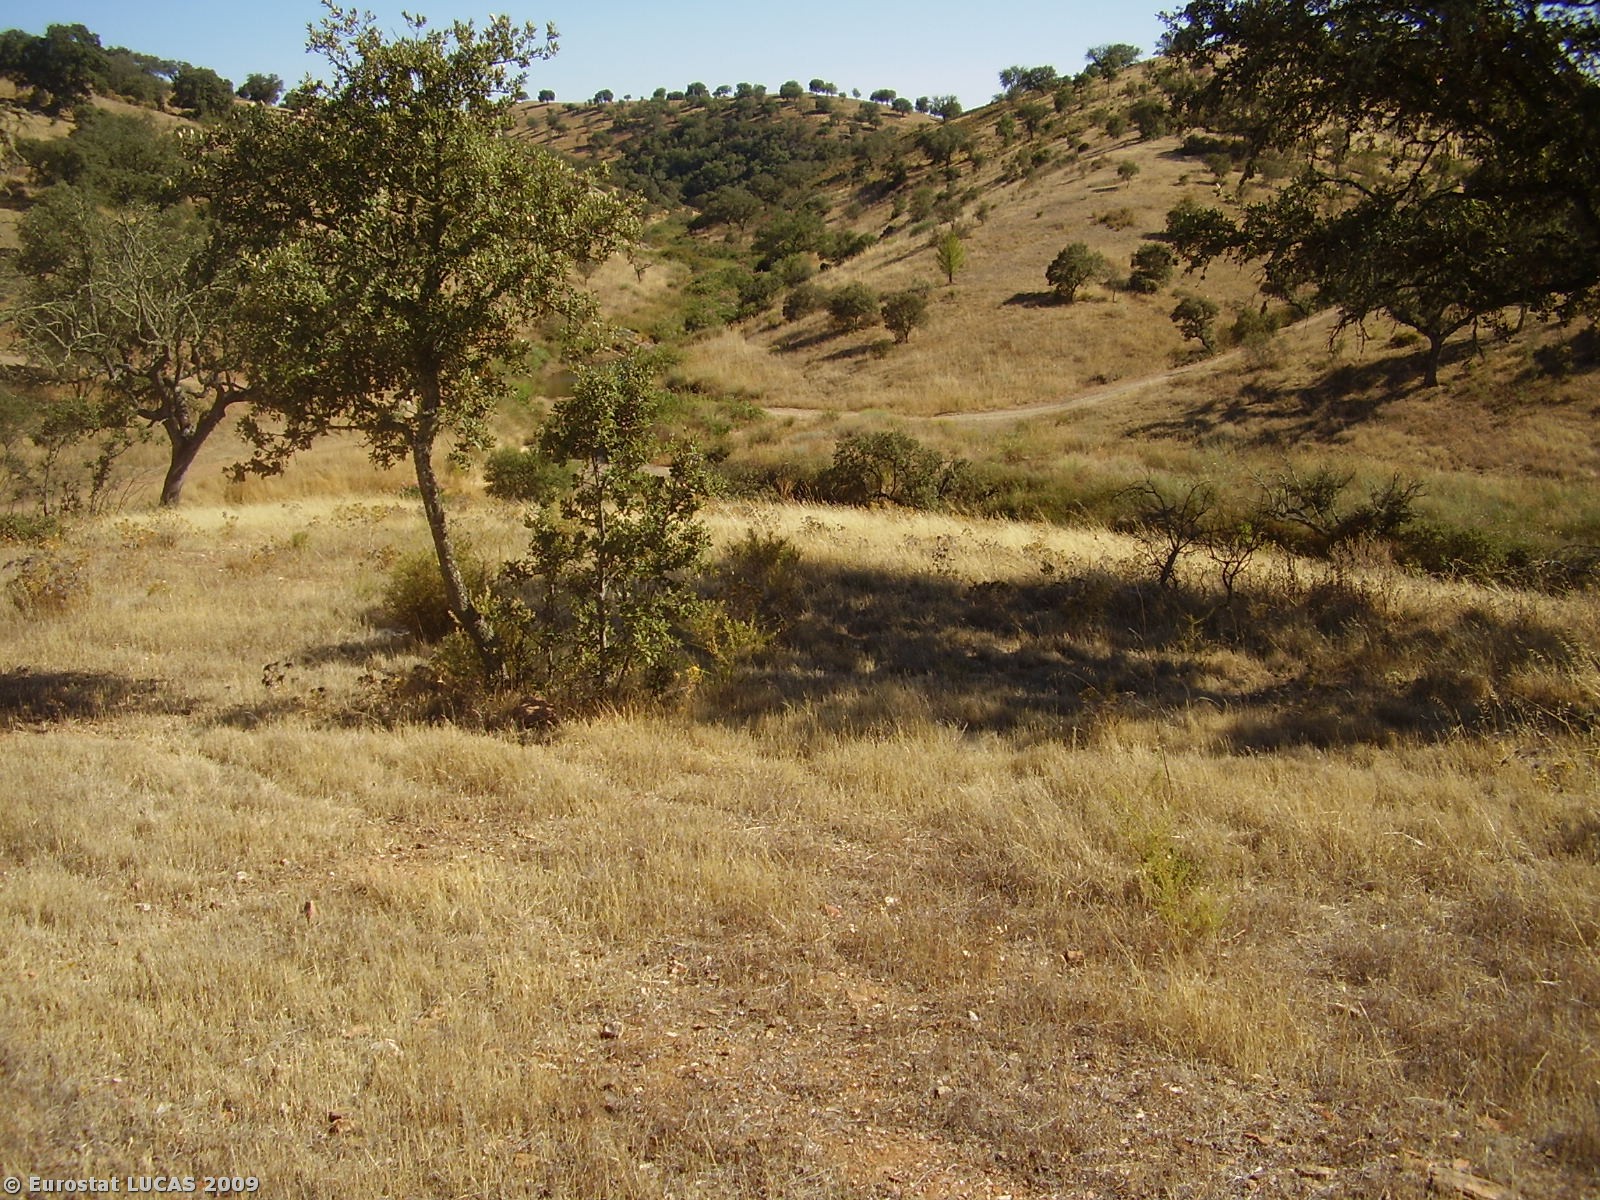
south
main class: Grassland
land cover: Grassland with sparse tree/shrub cover
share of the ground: > 75 %
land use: Fallow land
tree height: > 5 m
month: July
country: PT
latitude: 37.8699
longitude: -7.4888
